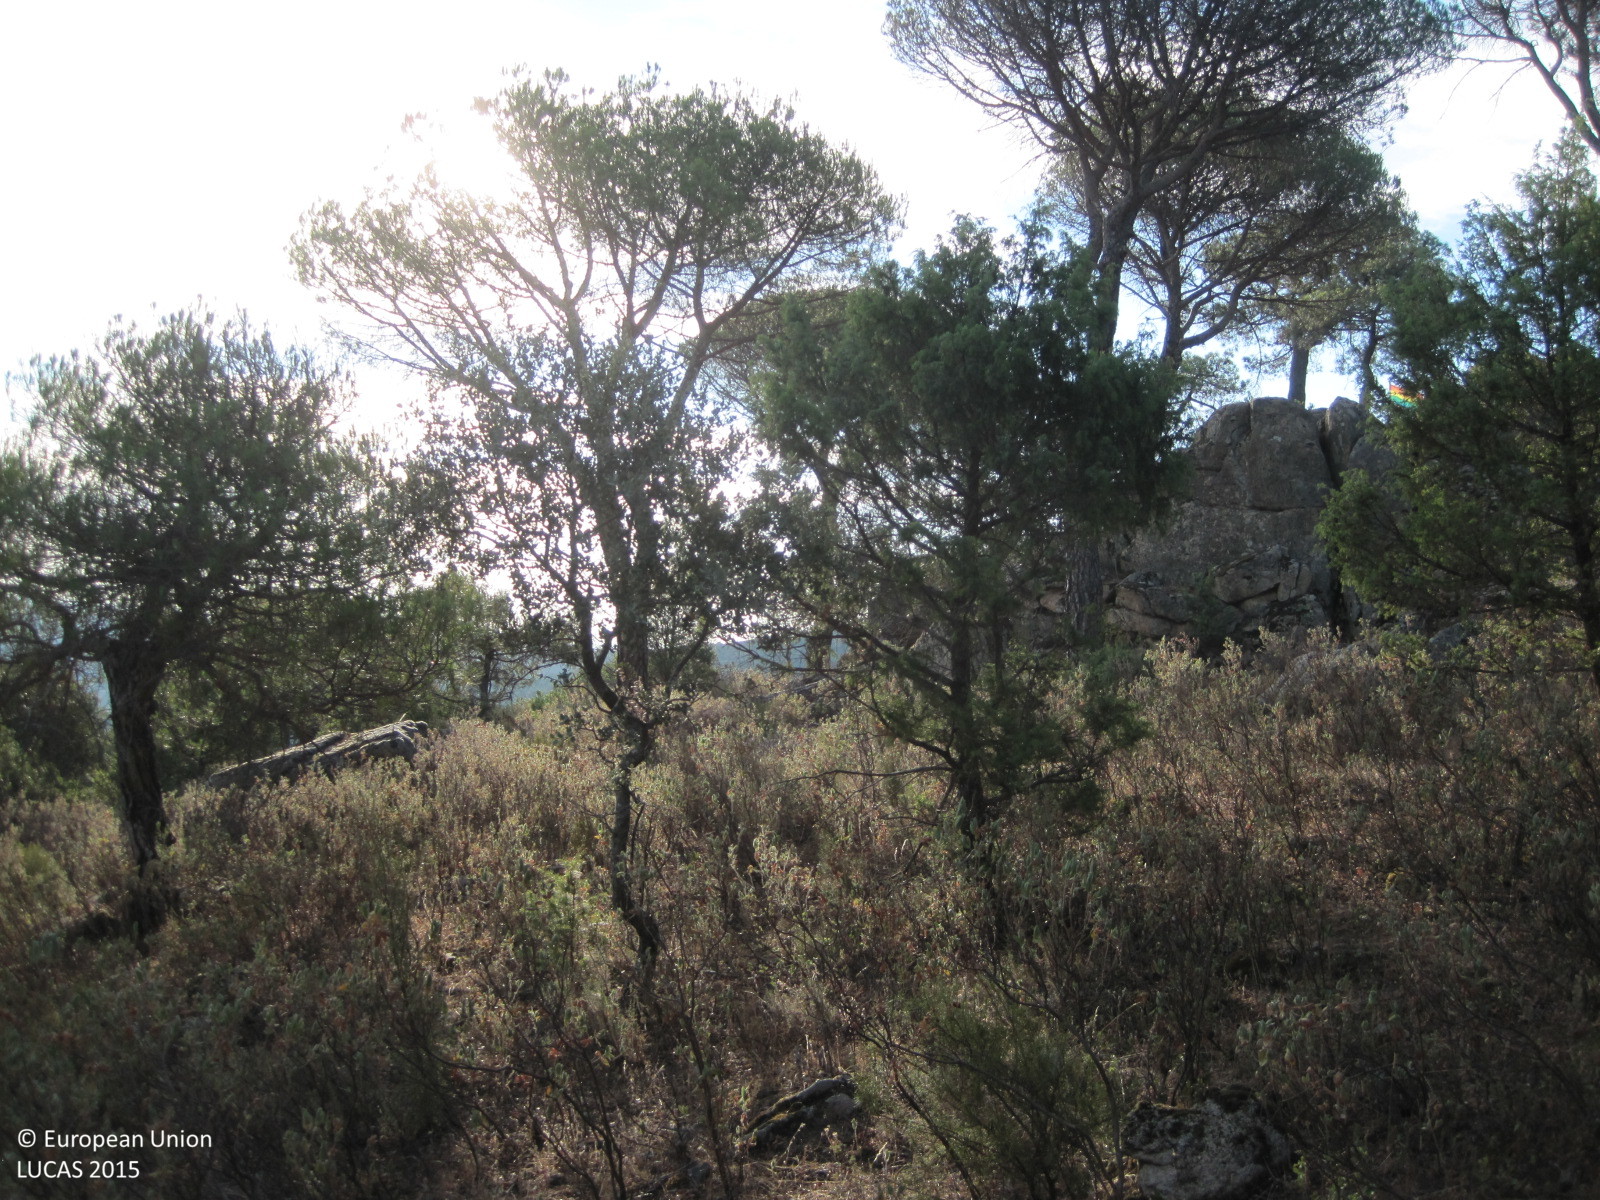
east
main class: Woodland
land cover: Pine dominated mixed woodland
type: coniferous forest of the mediterranean region
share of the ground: > 75 %
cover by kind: coniferous forest trees 50 %, broadleaved forest trees 25 %, shrubs 10 %, herbaceous plants 10 %, unconsolidated bare surface 5 %
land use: Semi-natural and natural areas not in use
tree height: > 5 m
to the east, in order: Pine dominated mixed woodland; Rock outcrops; Pine dominated mixed woodland; Pine dominated coniferous woodland
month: July
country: ES
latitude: 40.3401
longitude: -4.3724
